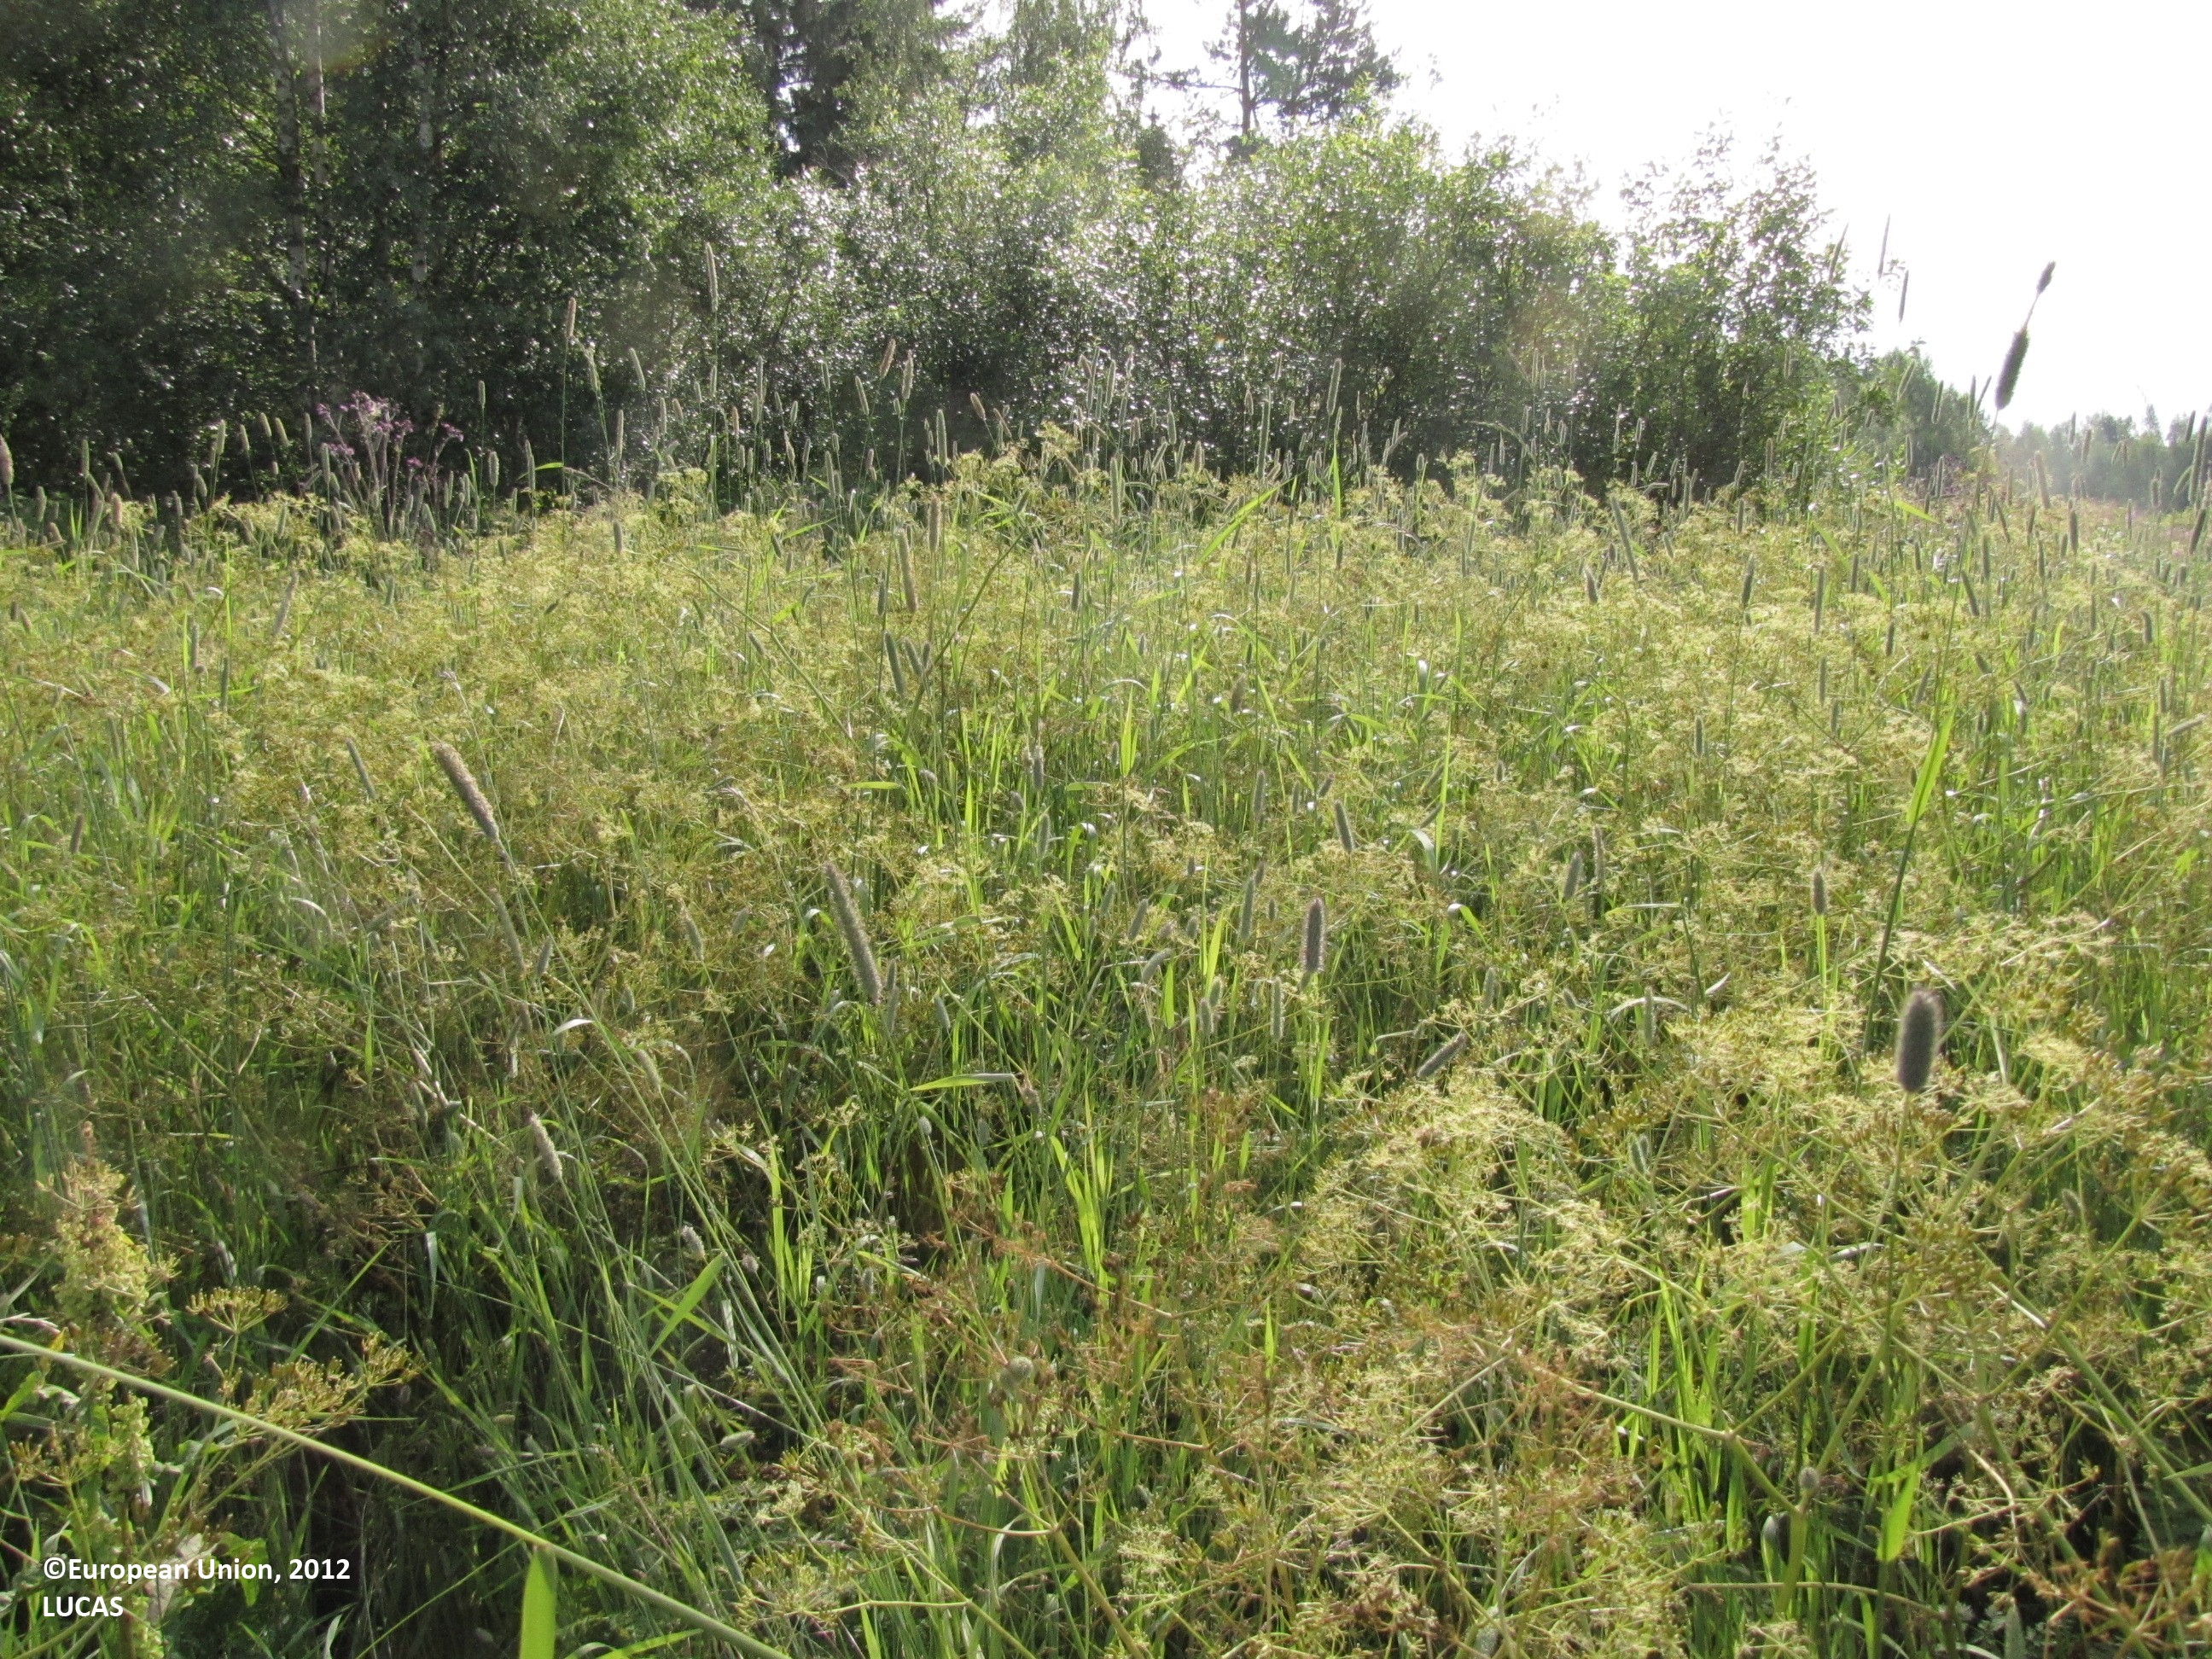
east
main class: Grassland
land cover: Spontaneously vegetated surfaces
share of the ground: > 75 %
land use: Agriculture (excluding fallow land and kitchen gardens)
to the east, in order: Spontaneously vegetated surfaces; Shrubland with sparse tree cover; Spruce dominated mixed woodland; Spruce dominated coniferous woodland; Grass margins; Ditches and canals; Grass margins; Paved roads, cycling and walking lanes; Grass margins; Ditches and canals; Spruce dominated mixed woodland; Broadleaved woodland
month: July
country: FI
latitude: 62.6860
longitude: 23.0128
